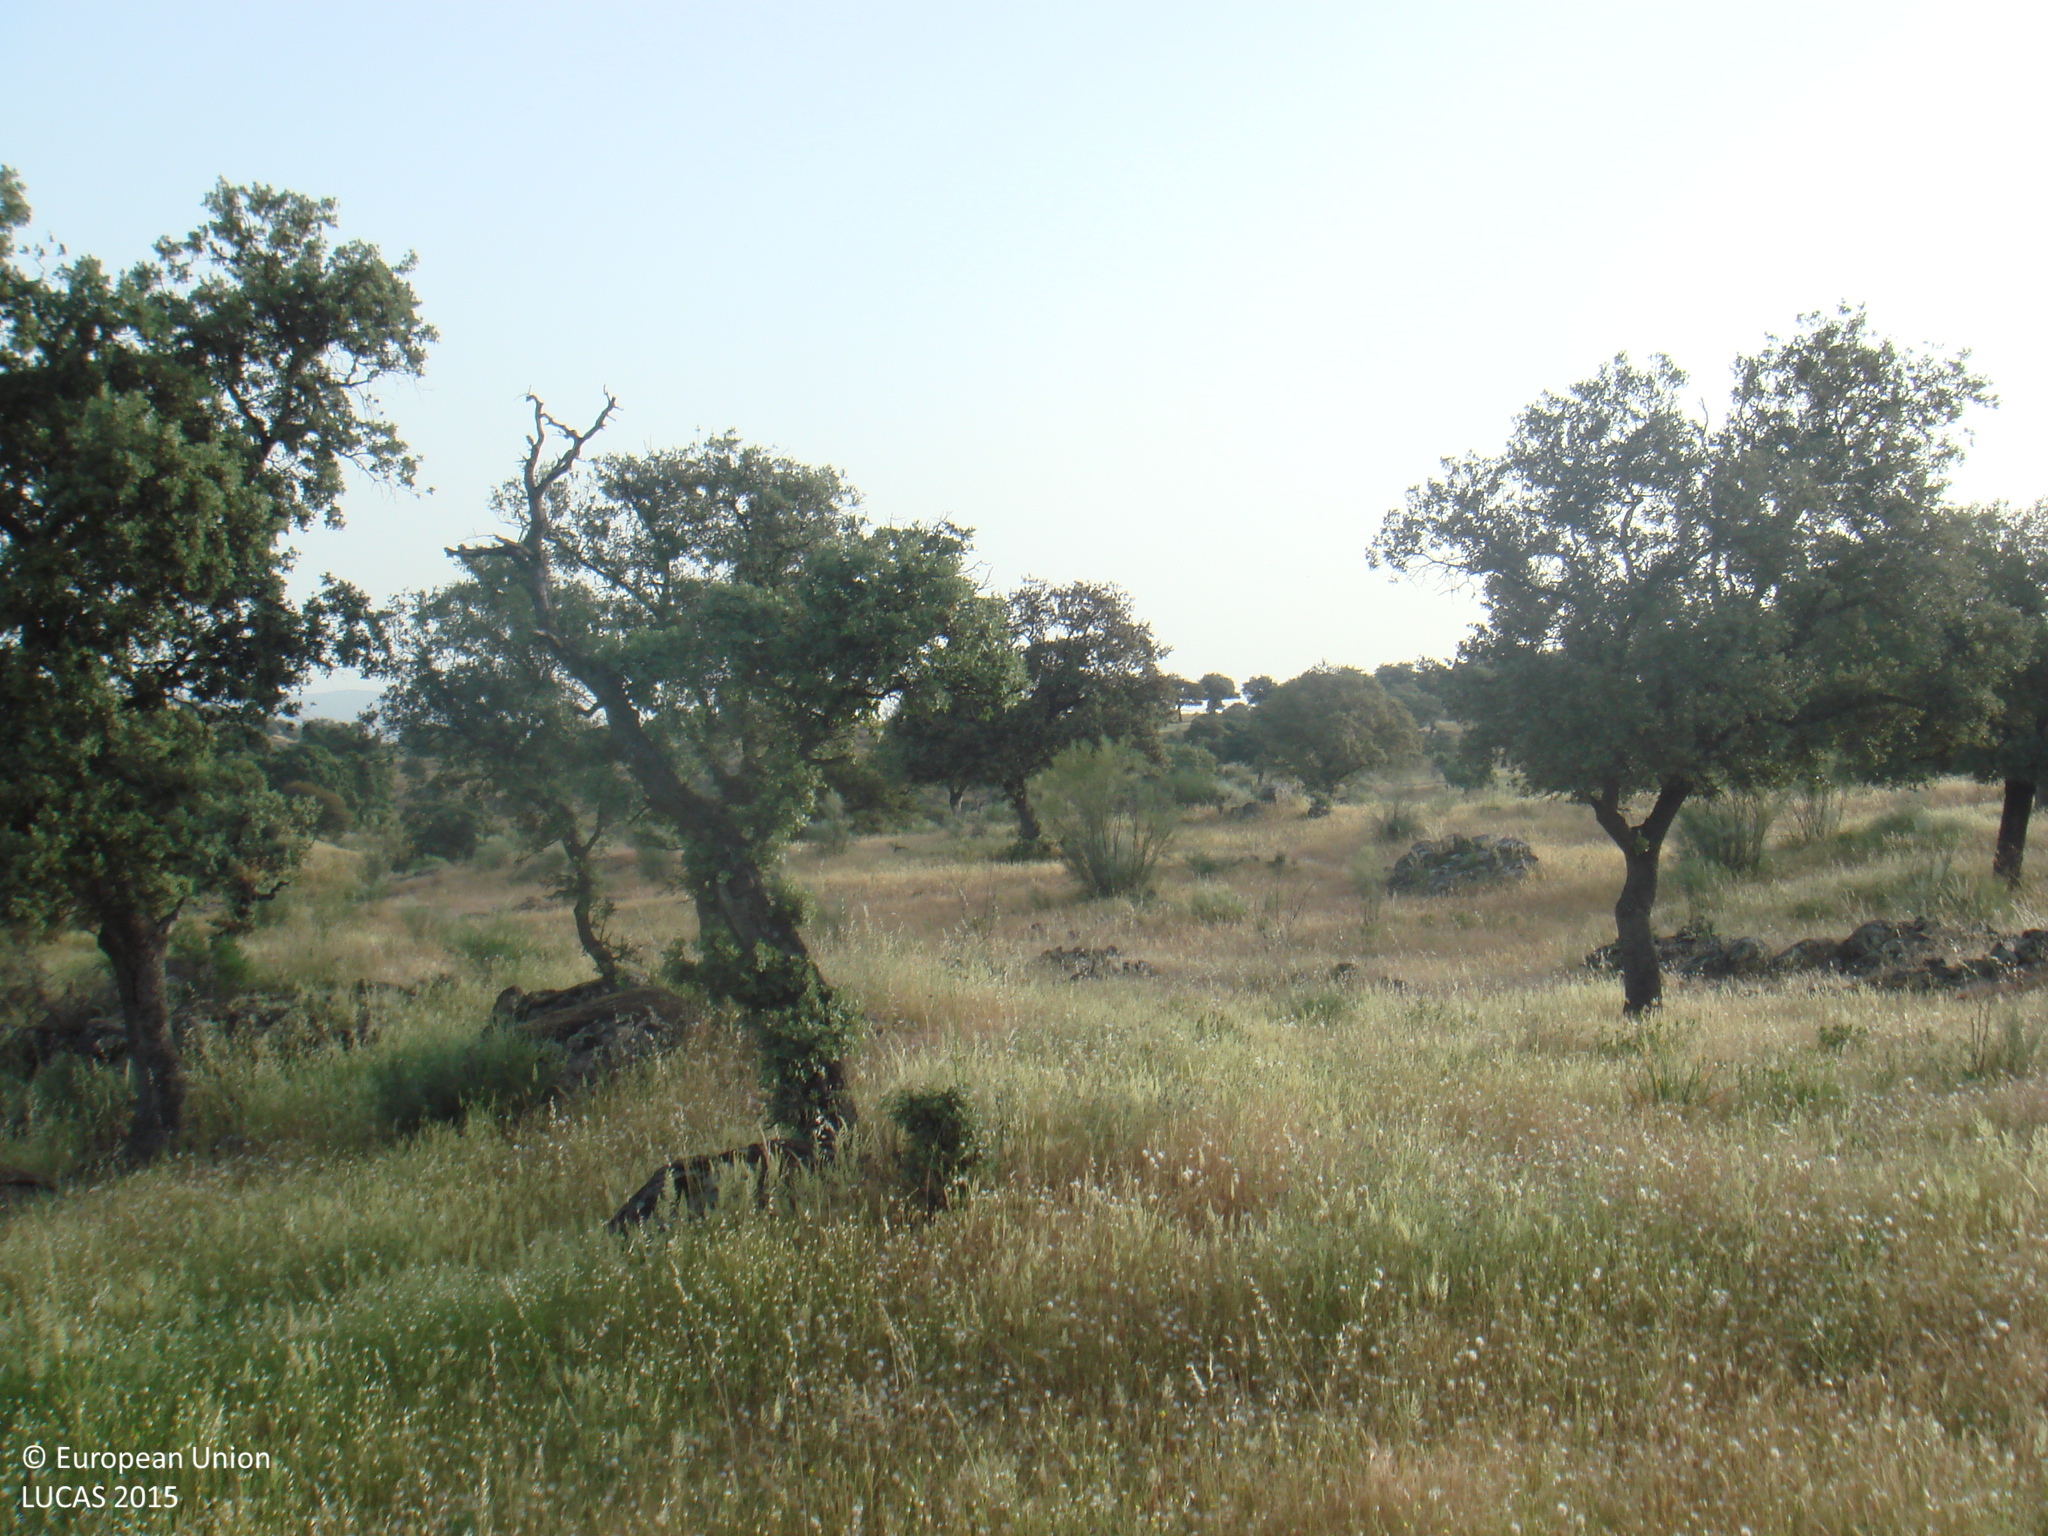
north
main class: Woodland
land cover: Broadleaved woodland
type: broadleaved evergreen forest
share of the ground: 50 - 75 %
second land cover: Spontaneously vegetated surfaces
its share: > 75 %
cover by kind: herbaceous plants 60 %, broadleaved forest trees 40 %
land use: Forestry
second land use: Agriculture (excluding fallow land and kitchen gardens)
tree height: > 5 m
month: May
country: ES
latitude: 38.4802
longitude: -4.7772
